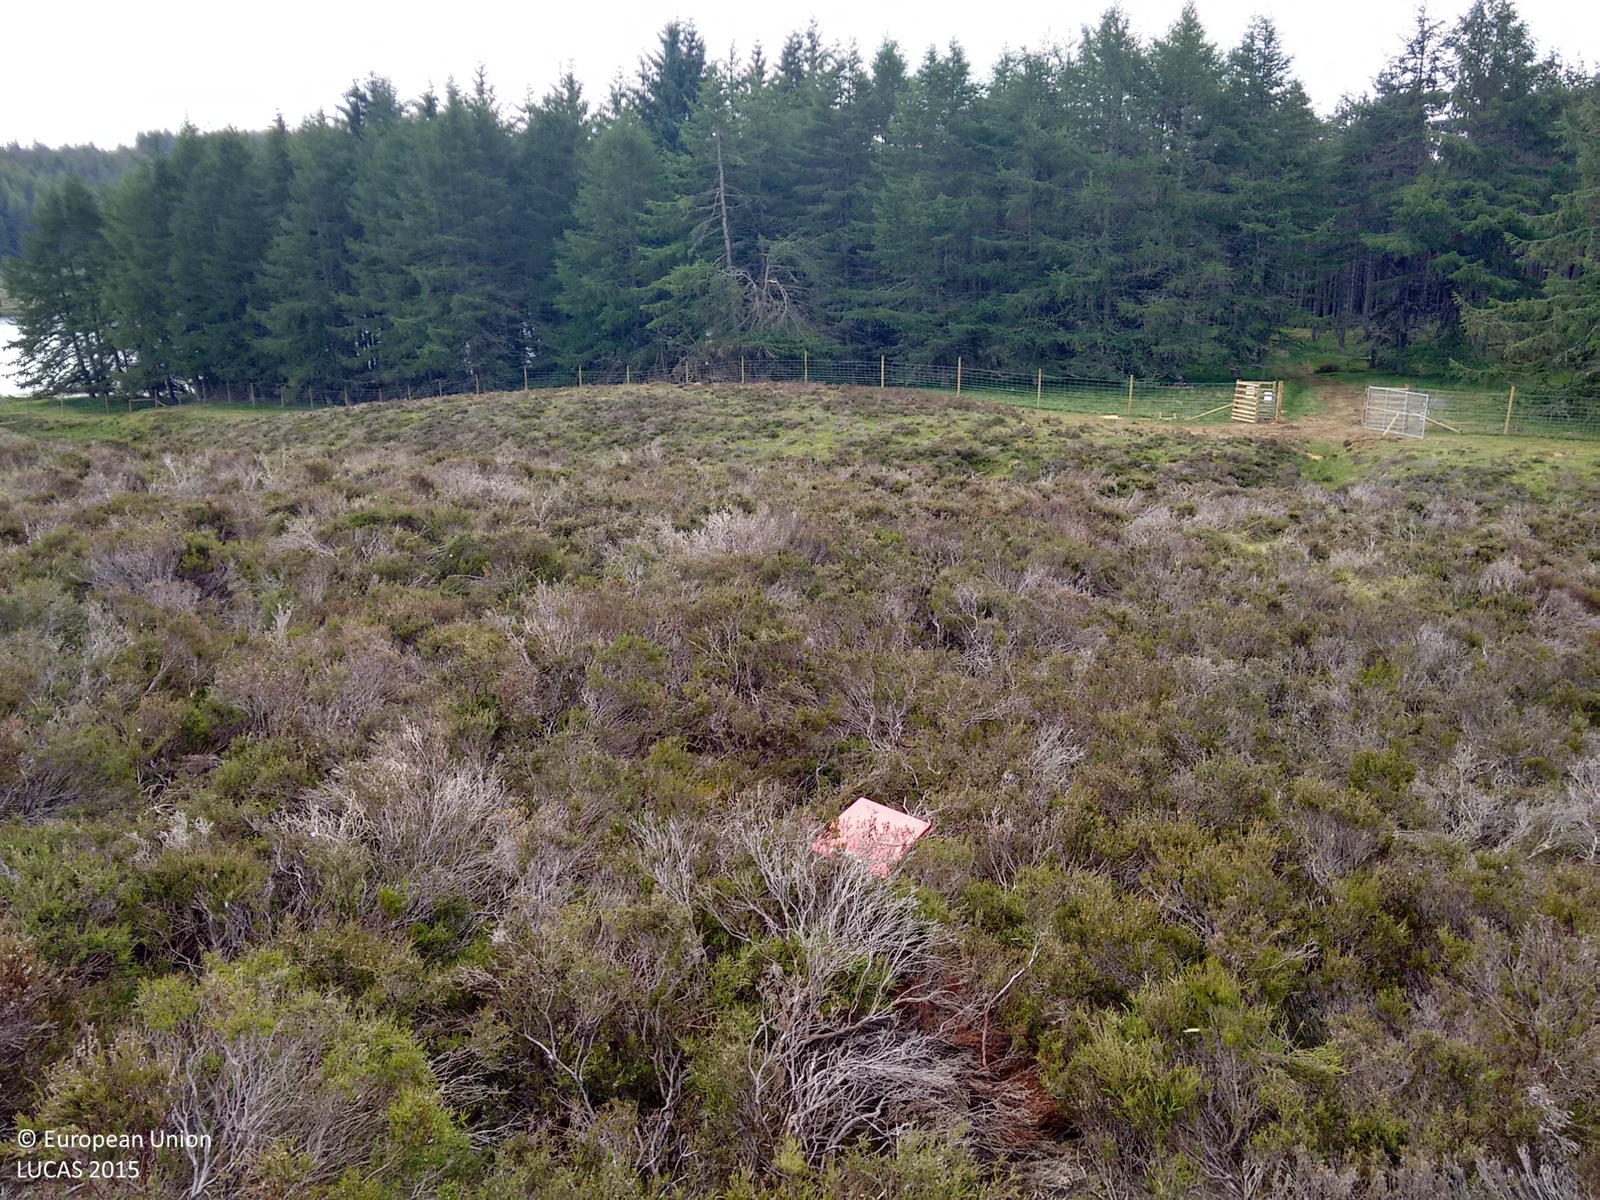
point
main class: Shrubland
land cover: Shrubland without tree cover
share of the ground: > 75 %
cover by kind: shrubs 95 %, herbaceous plants 5 %
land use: Semi-natural and natural areas not in use
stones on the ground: < 10 %
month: July
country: GB
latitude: 56.7391
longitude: -3.9297
